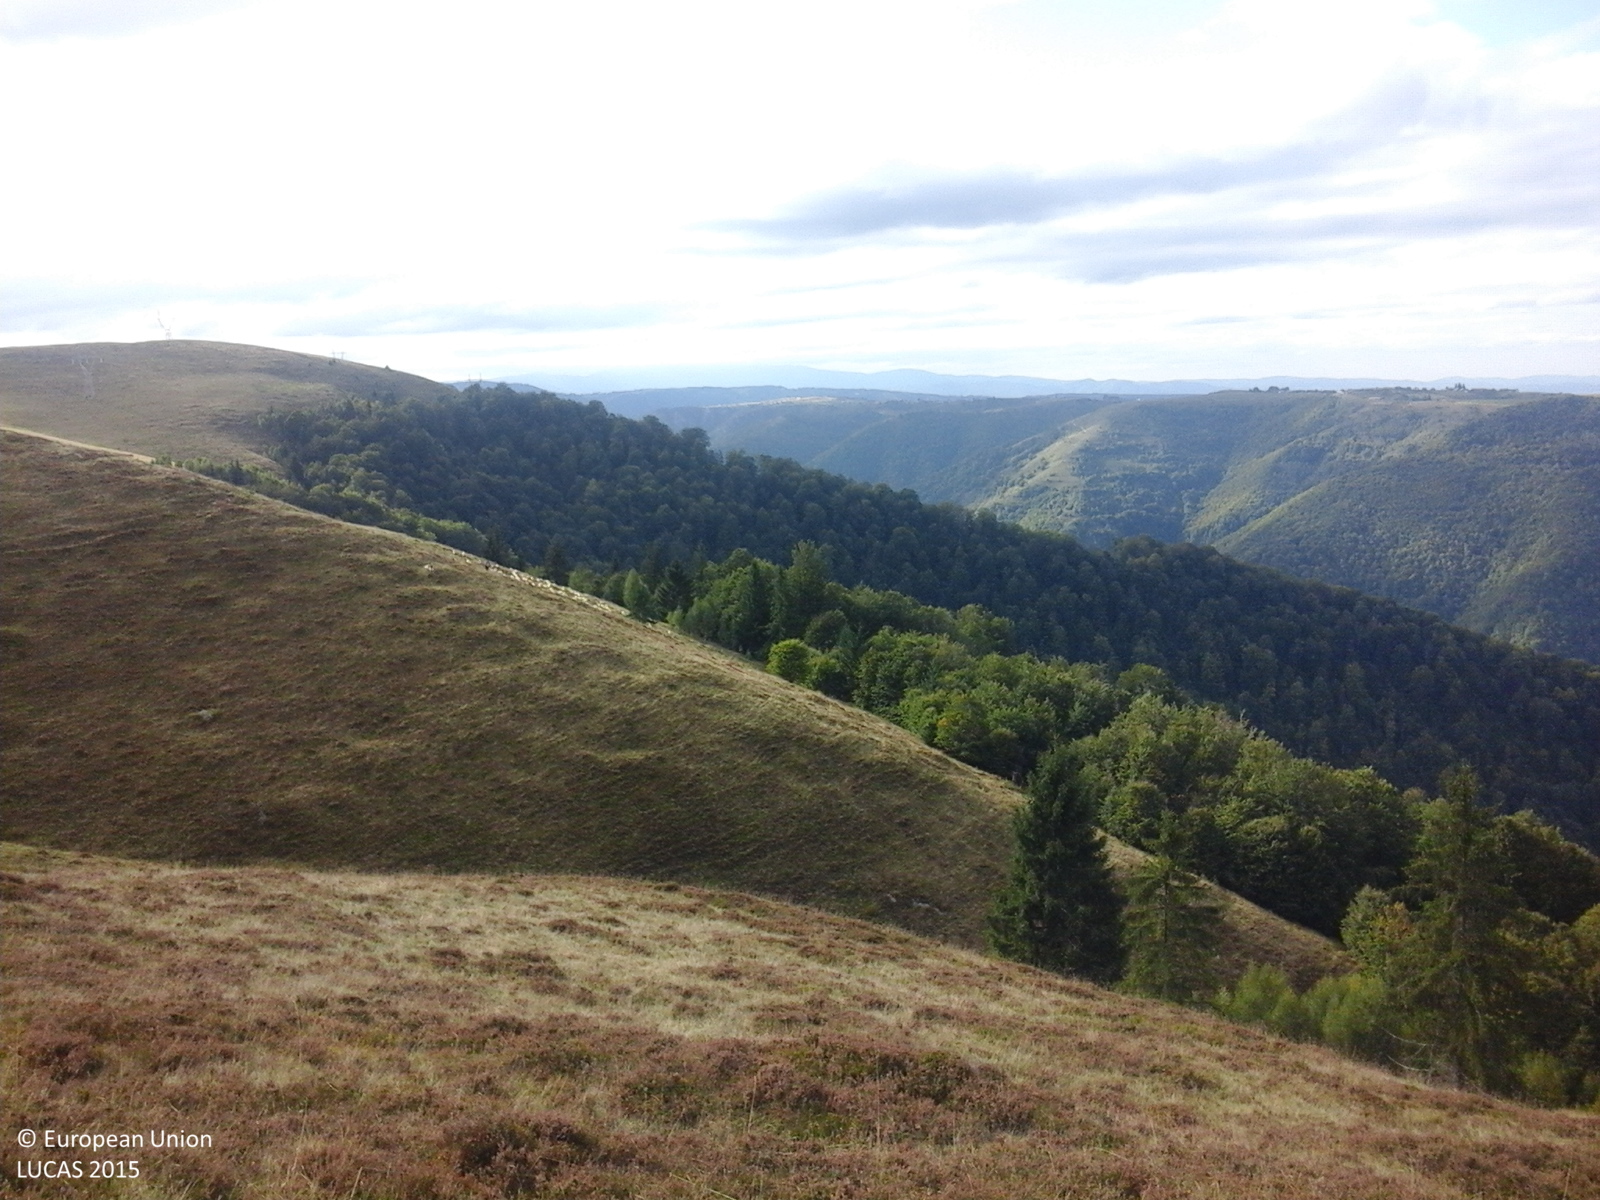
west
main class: Grassland
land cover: Grassland without tree/shrub cover
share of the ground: > 75 %
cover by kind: herbaceous plants 100 %
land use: Agriculture (excluding fallow land and kitchen gardens)
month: October
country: RO
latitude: 46.6922
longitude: 23.2322
